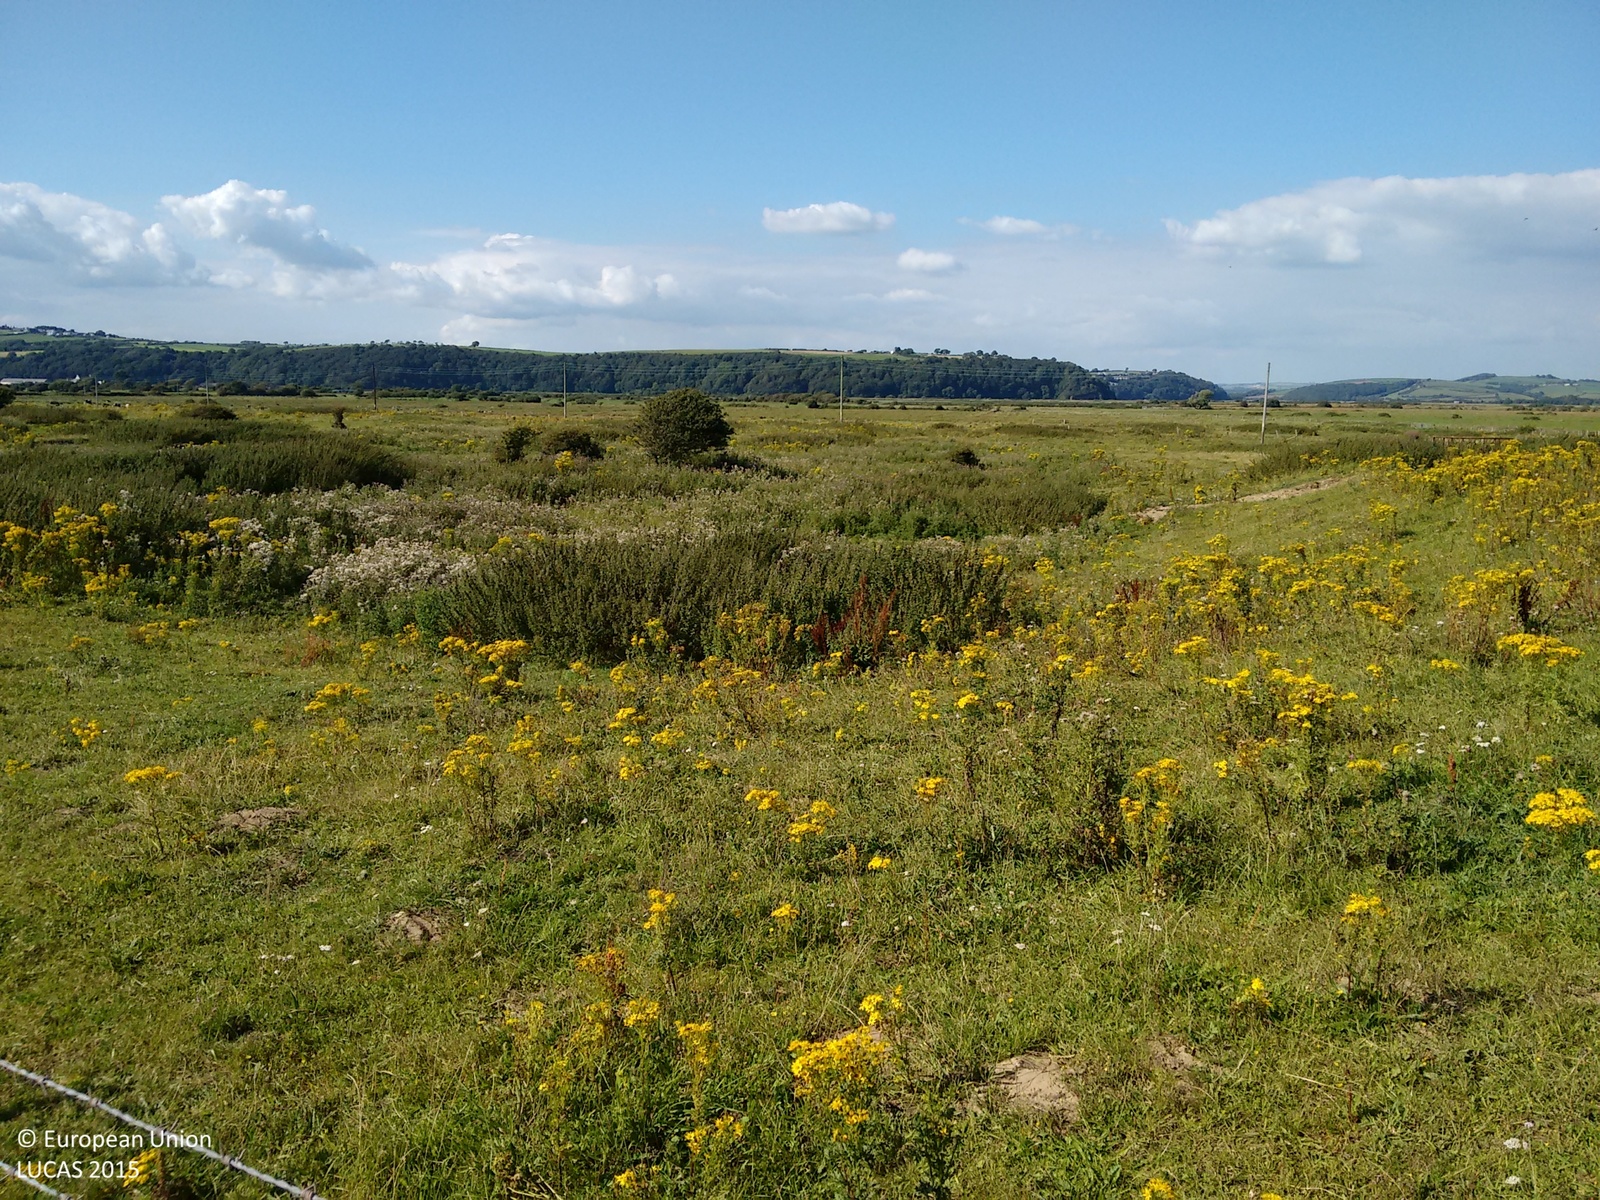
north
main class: Grassland
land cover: Grassland without tree/shrub cover
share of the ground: > 75 %
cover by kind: herbaceous plants 100 %
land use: Agriculture (excluding fallow land and kitchen gardens)
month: August
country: GB
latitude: 51.7420
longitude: -4.4567
